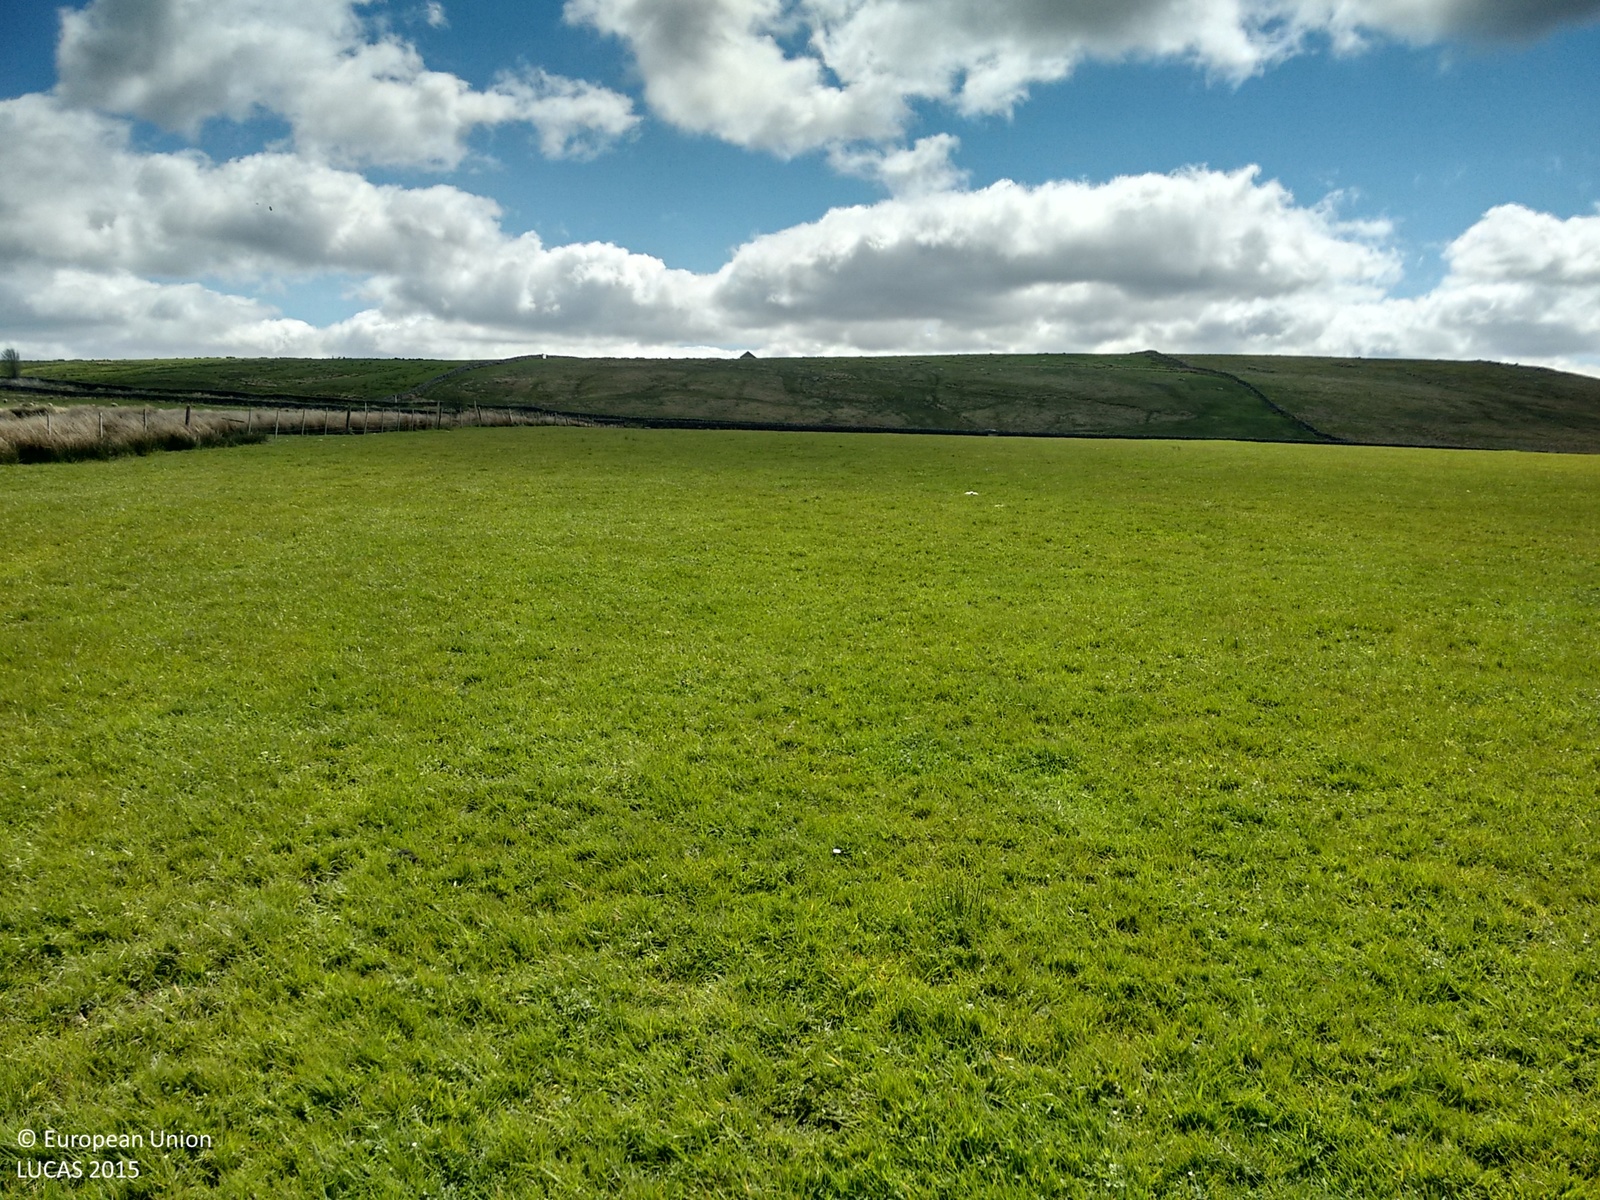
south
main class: Grassland
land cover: Grassland without tree/shrub cover
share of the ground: > 75 %
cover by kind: herbaceous plants 100 %
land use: Agriculture (excluding fallow land and kitchen gardens)
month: May
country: GB
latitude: 54.9243
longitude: -2.4353
